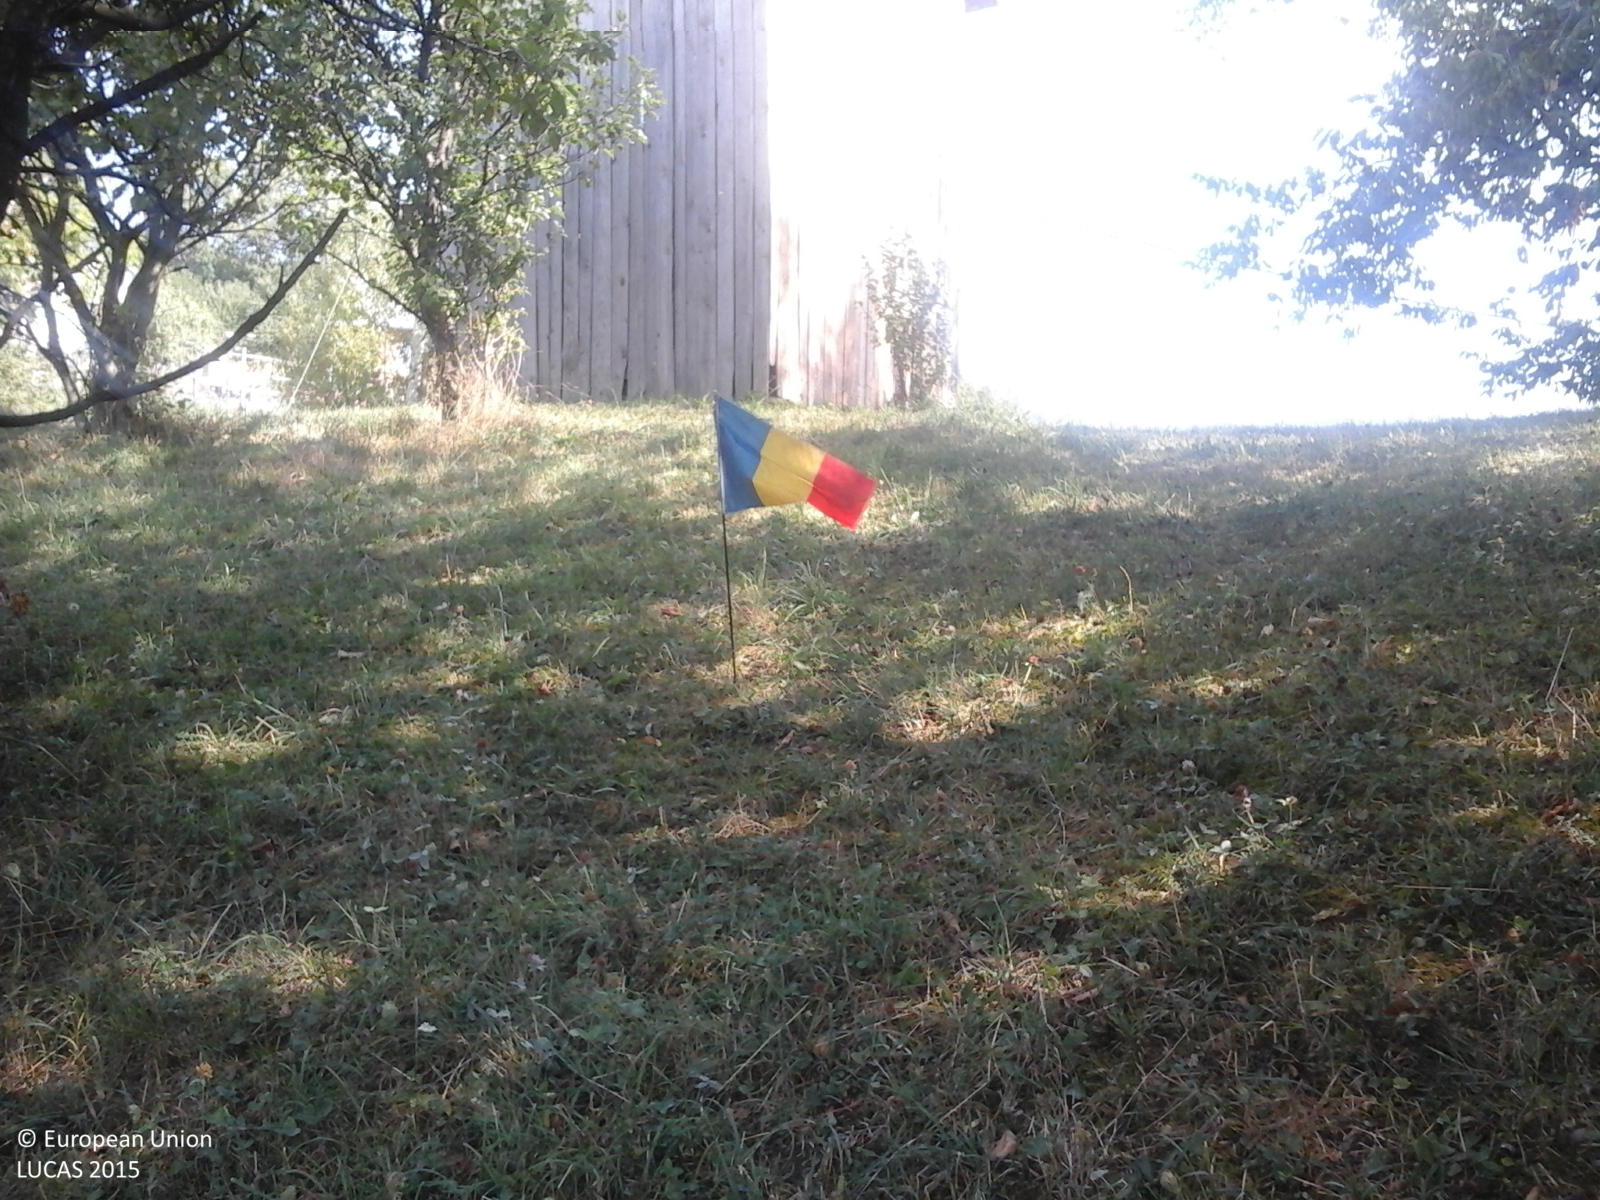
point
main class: Grassland
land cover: Grassland with sparse tree/shrub cover
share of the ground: > 75 %
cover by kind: herbaceous plants 85 %, shrubs 10 %, broadleaved forest trees 5 %
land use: Agriculture (excluding fallow land and kitchen gardens)
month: September
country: RO
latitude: 47.6620
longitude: 24.6250
